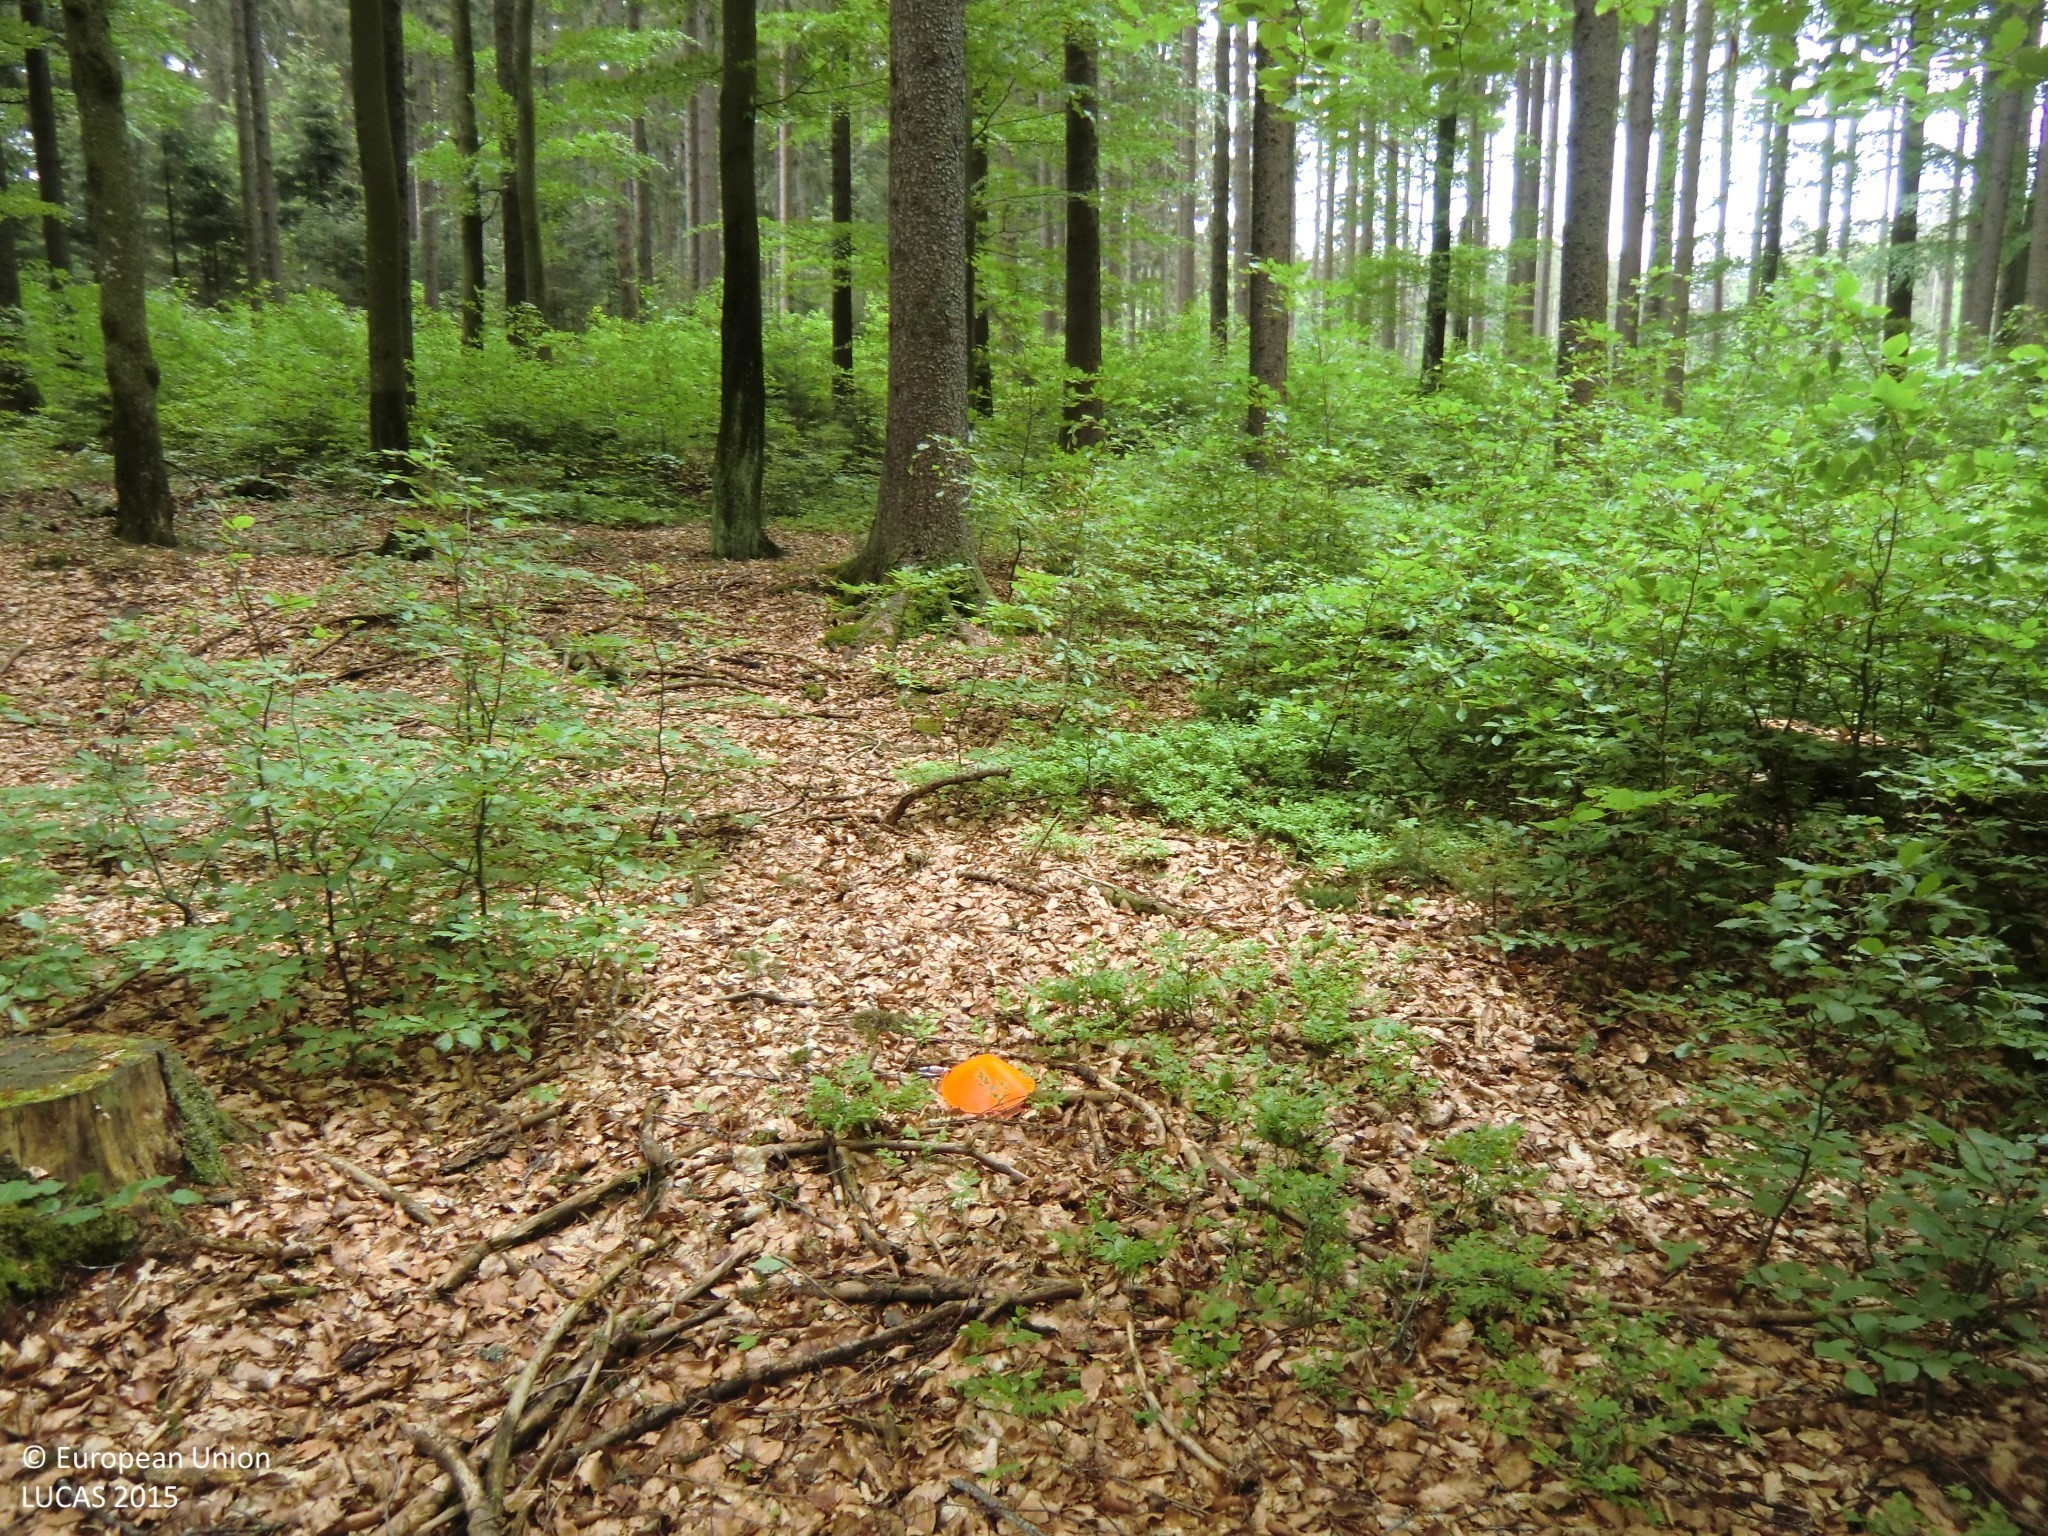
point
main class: Woodland
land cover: Spruce dominated mixed woodland
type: hemiboreal forest and nemoral coniferous forest and mixed broadleaved-coniferous forest
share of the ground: > 75 %
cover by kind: coniferous forest trees 45 %, broadleaved forest trees 45 %, herbaceous plants 5 %, unconsolidated bare surface 5 %
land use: Forestry
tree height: > 5 m
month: May
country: AT
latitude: 48.3621
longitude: 15.0089
